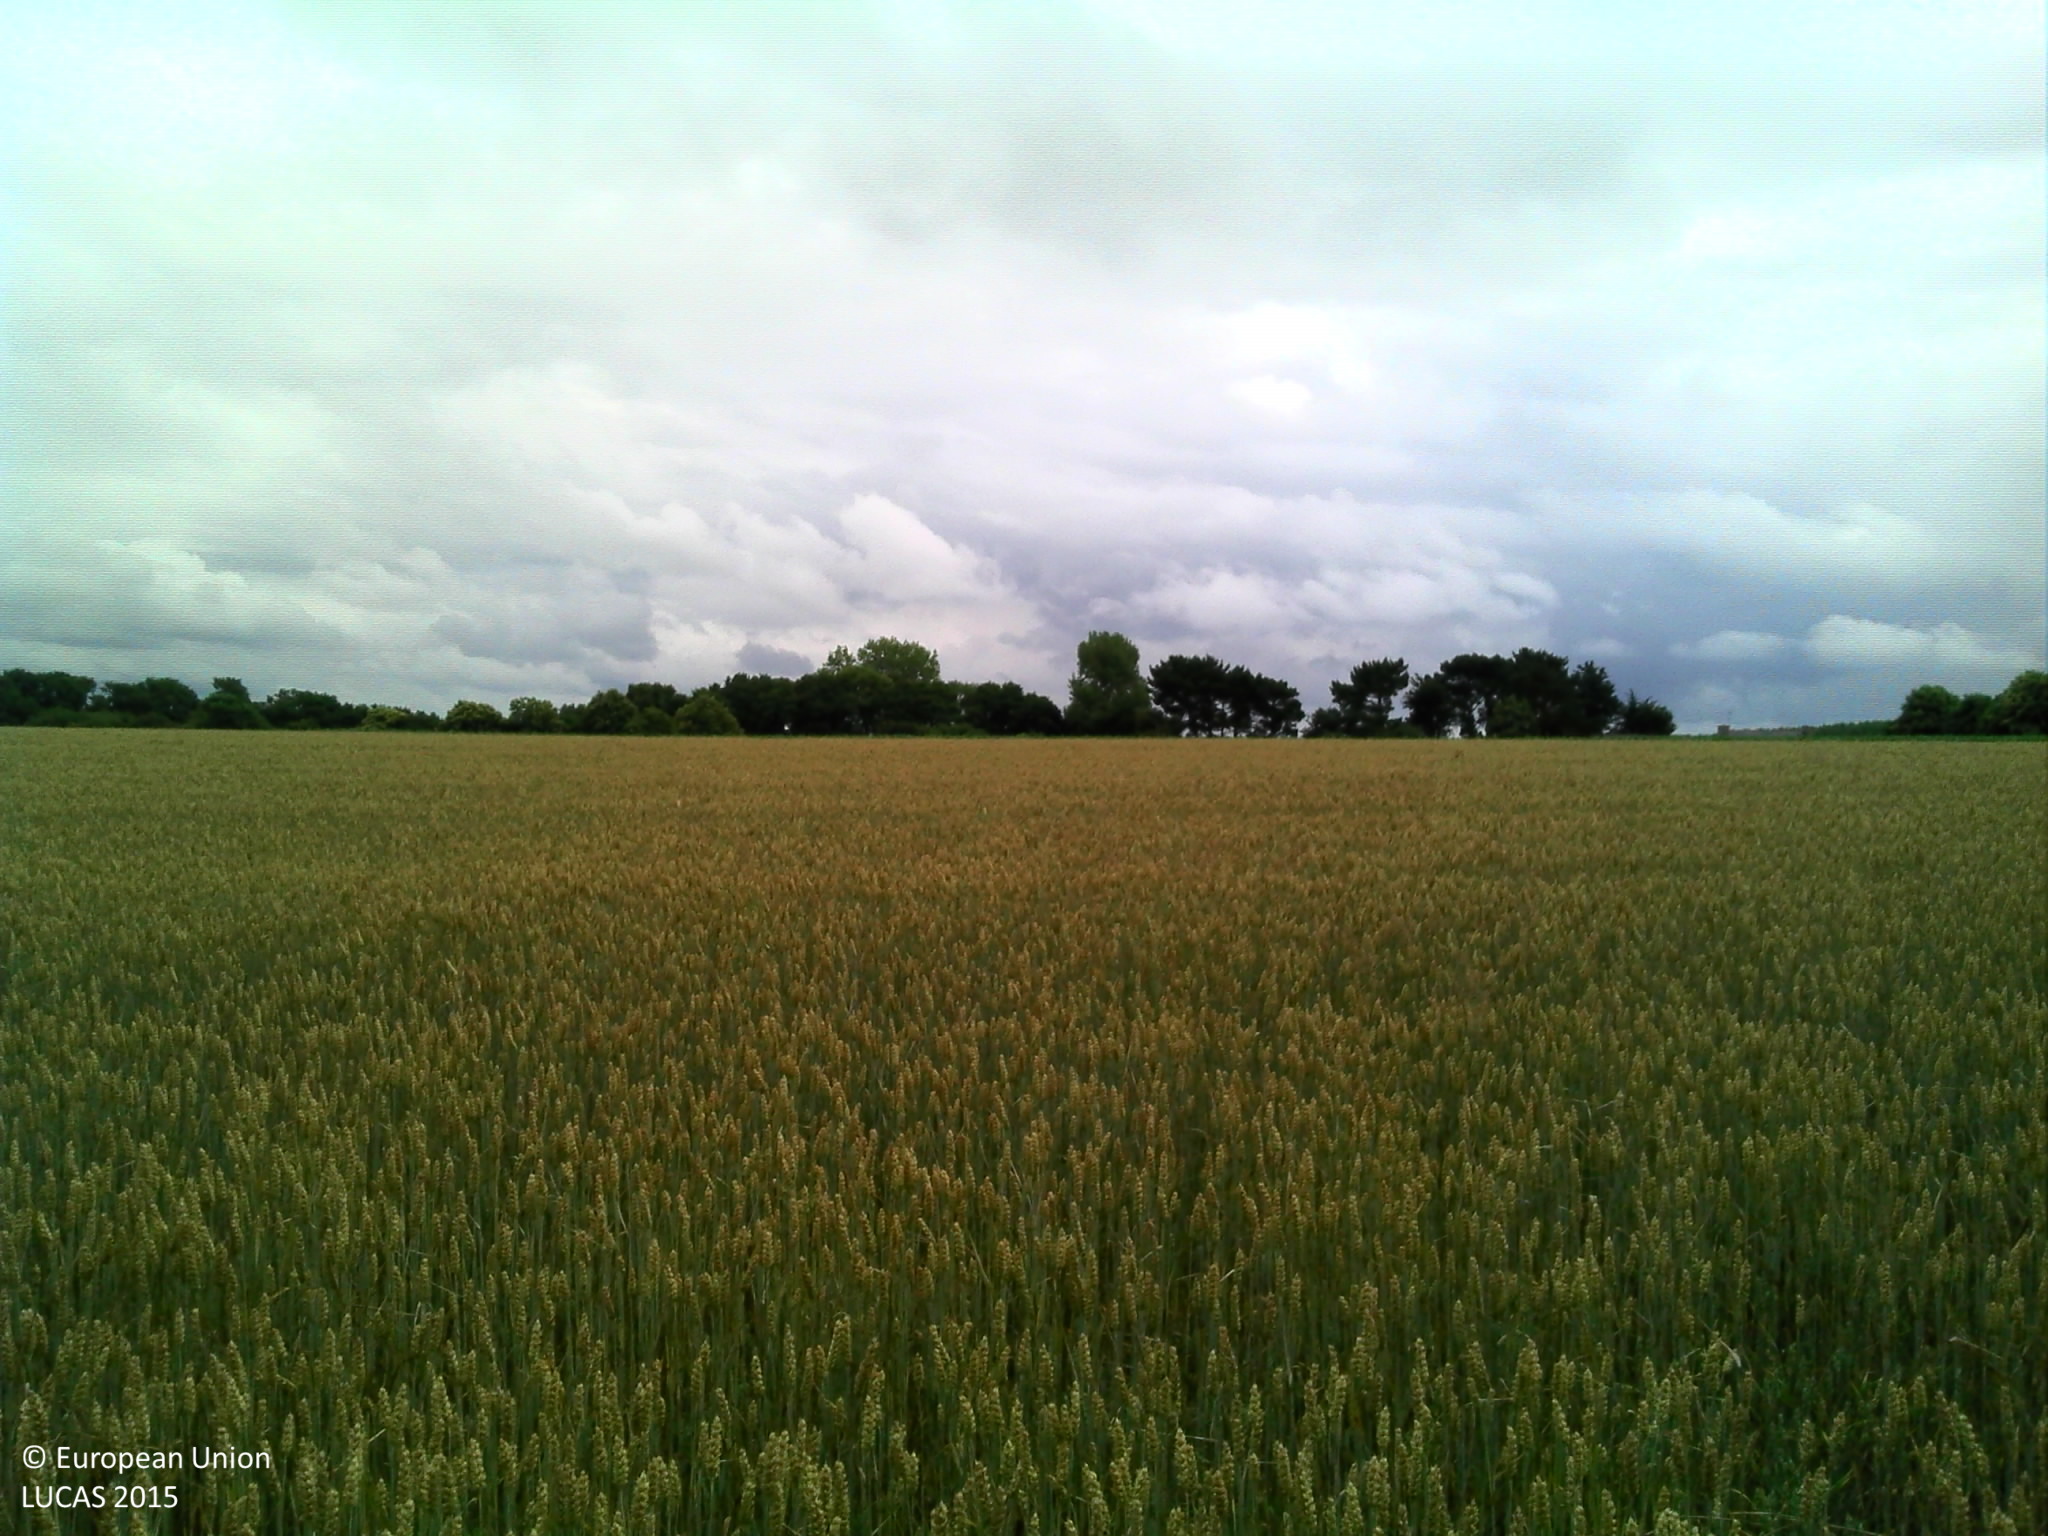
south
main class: Cropland
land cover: Common wheat
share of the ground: > 75 %
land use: Agriculture (excluding fallow land and kitchen gardens)
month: July
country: FR
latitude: 48.6676
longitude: -3.4813
